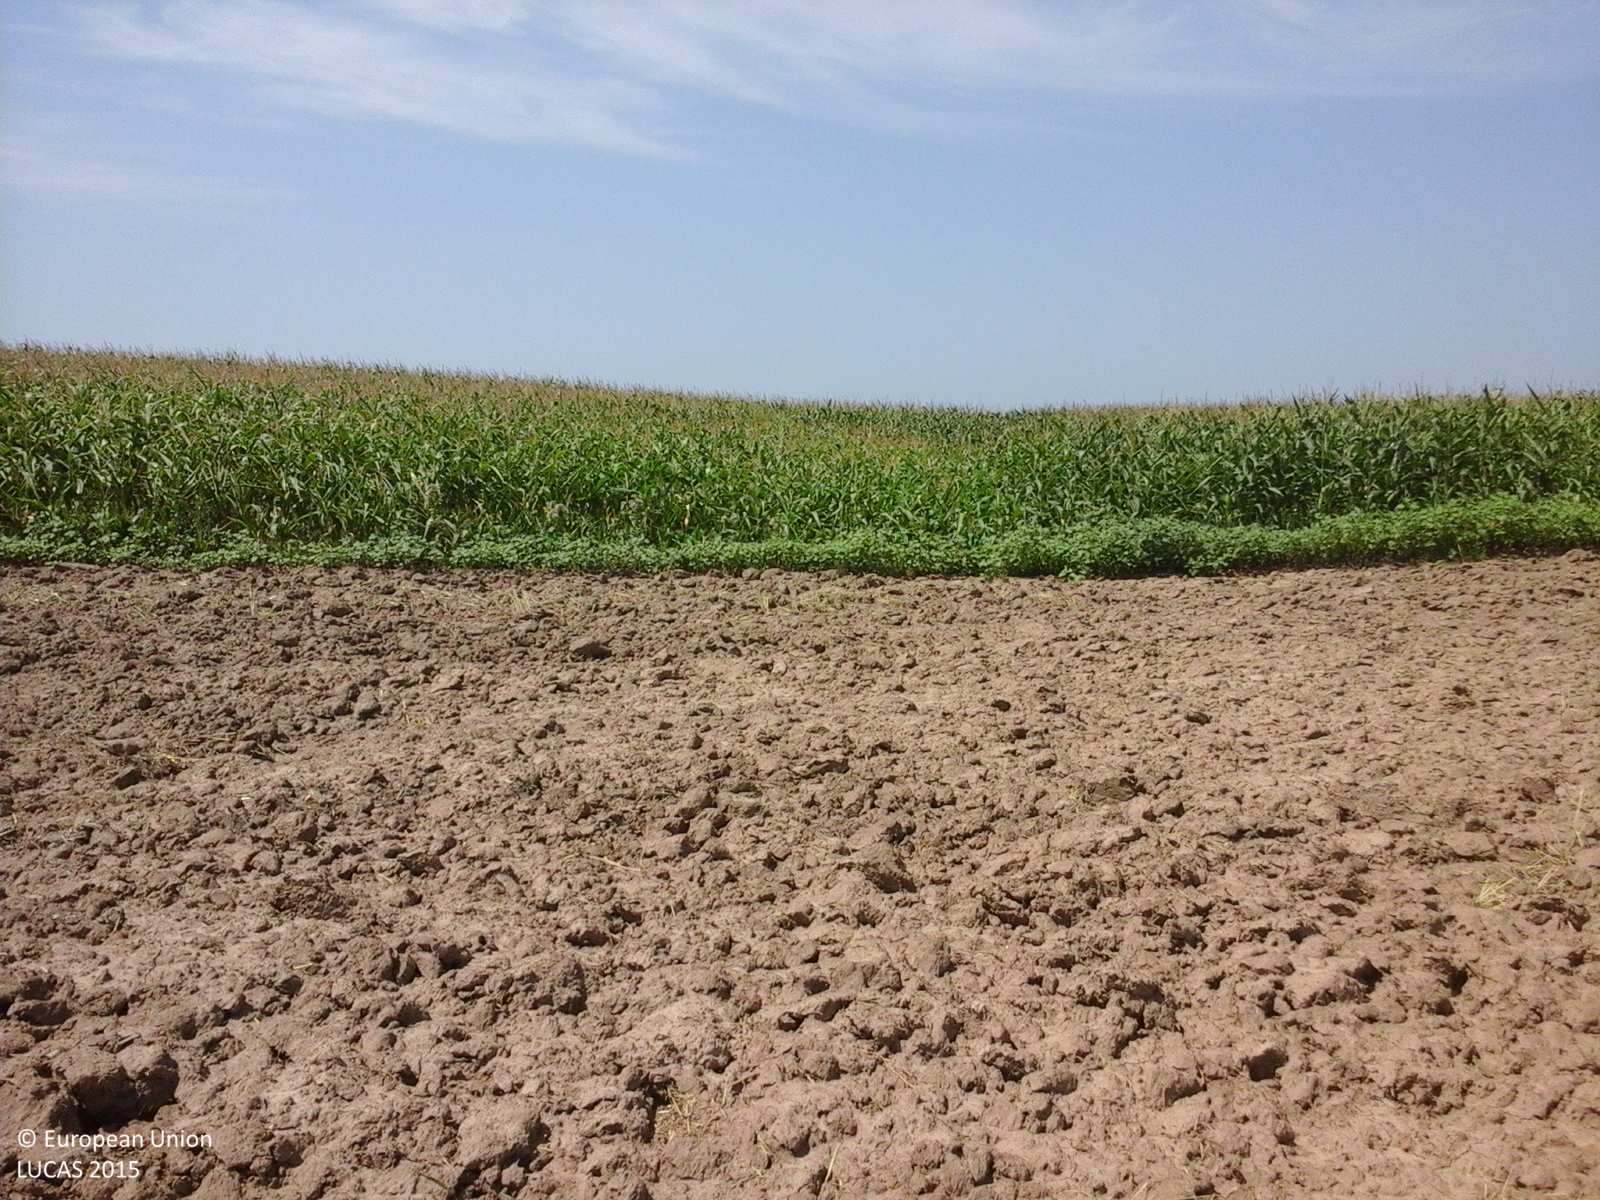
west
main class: Cropland
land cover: Common wheat
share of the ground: < 10 %
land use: Agriculture (excluding fallow land and kitchen gardens)
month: August
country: RO
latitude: 46.2351
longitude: 27.0703
